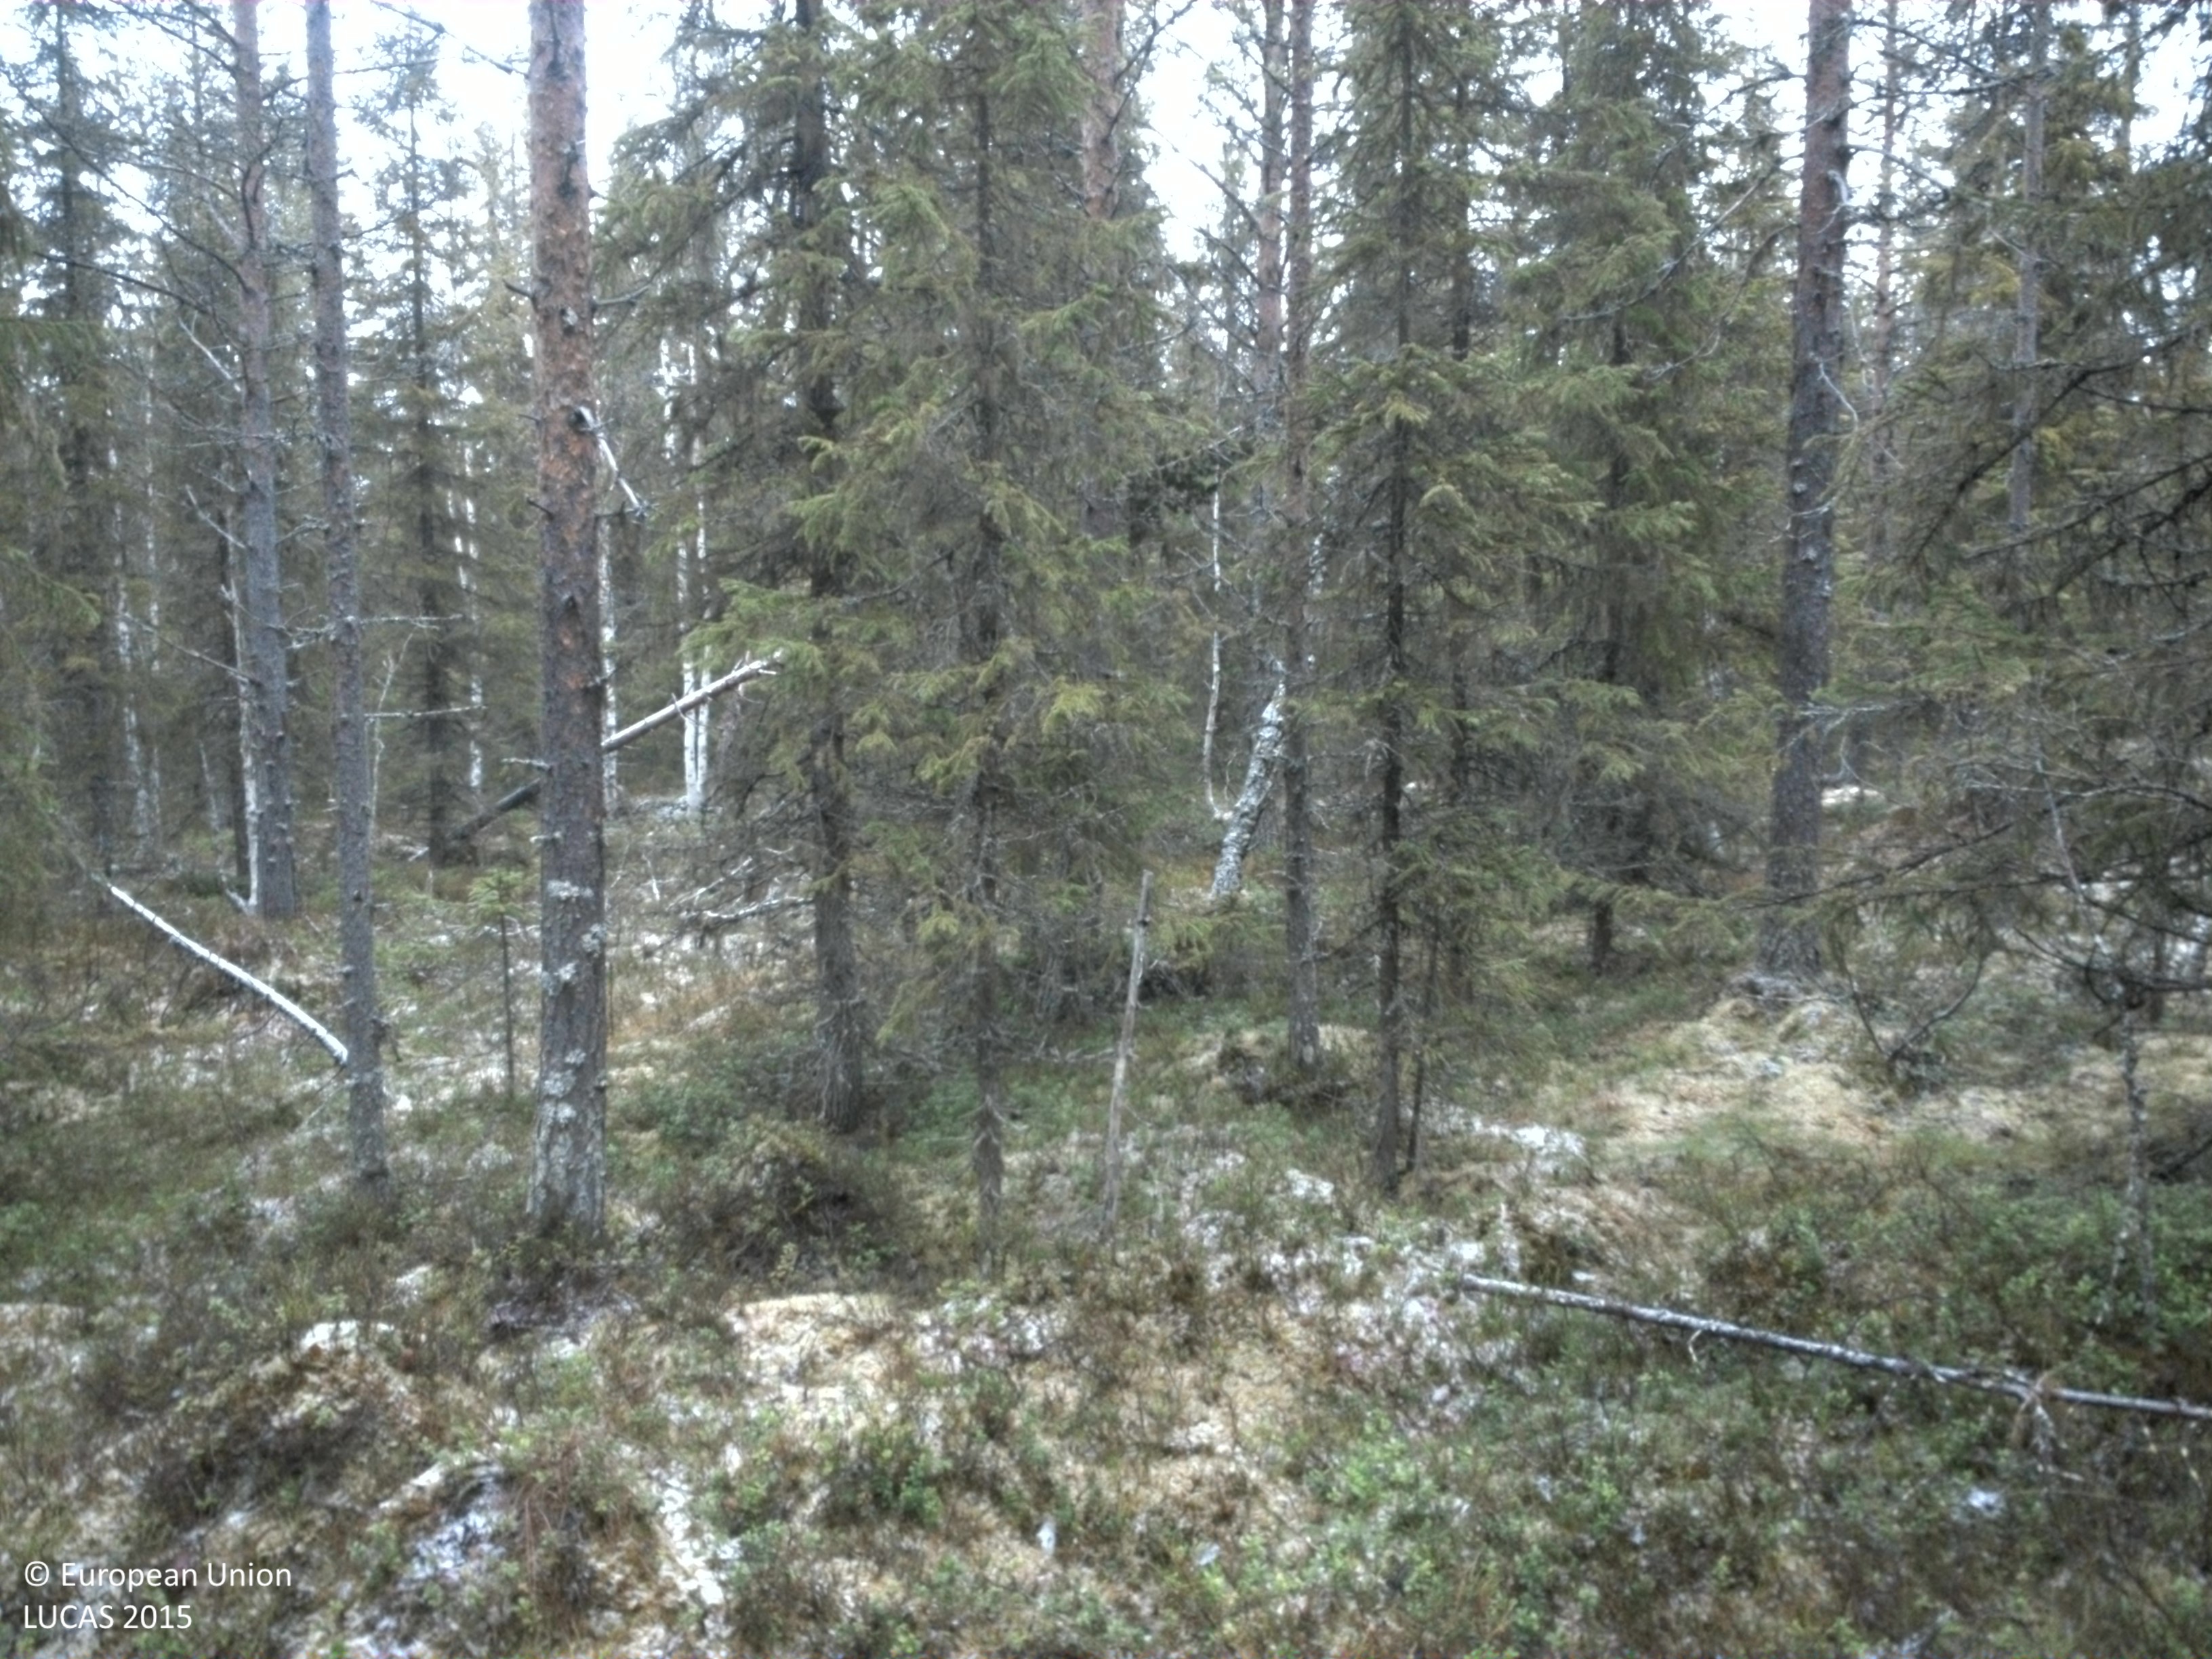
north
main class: Woodland
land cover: Other coniferous woodland
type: boreal forest
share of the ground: 25 - 50 %
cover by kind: coniferous forest trees 35 %, shrubs 35 %, lichens and mosses 20 %, broadleaved forest trees 5 %, herbaceous plants 5 %
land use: Forestry
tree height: > 5 m
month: October
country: SE
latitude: 64.3636
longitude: 16.7423
